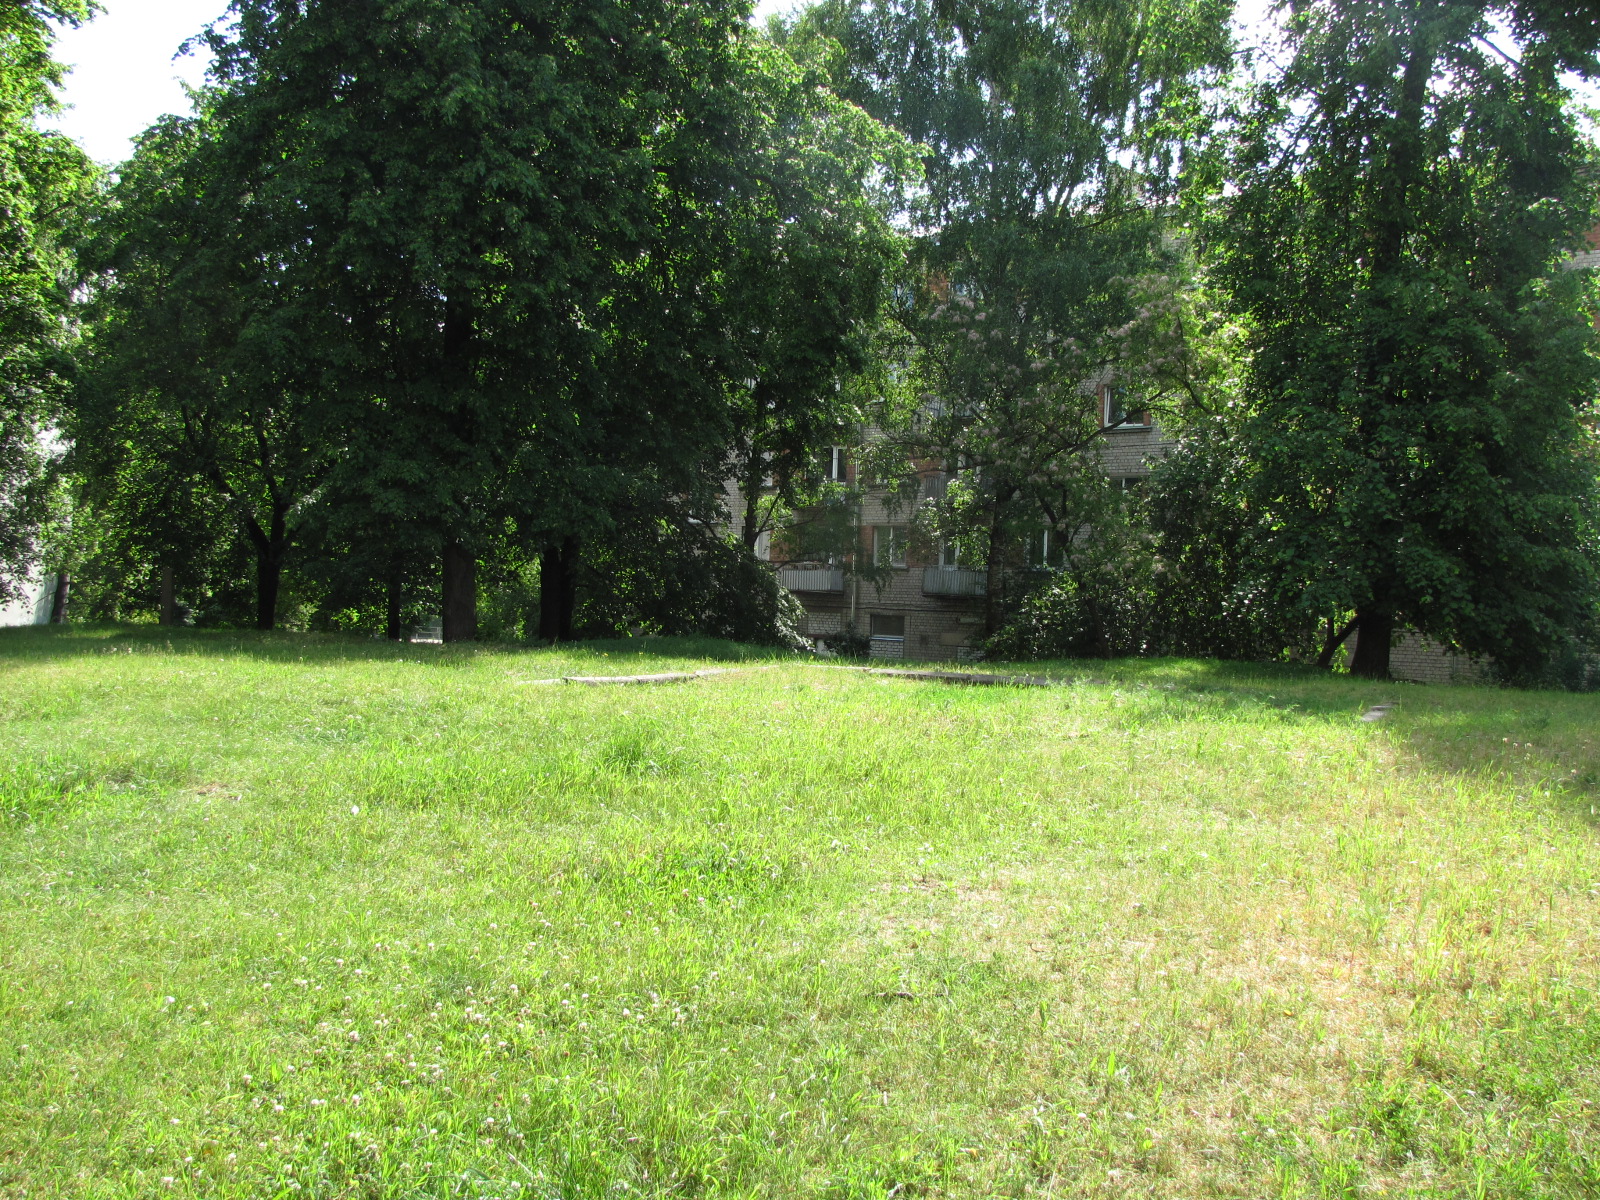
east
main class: Grassland
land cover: Grassland with sparse tree/shrub cover
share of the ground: > 75 %
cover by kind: herbaceous plants 95 %, broadleaved forest trees 5 %
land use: Residential
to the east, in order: Grassland with sparse tree/shrub cover; Broadleaved woodland; Artificial constructions in urban areas
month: June
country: LV
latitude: 56.9642
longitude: 24.0474
